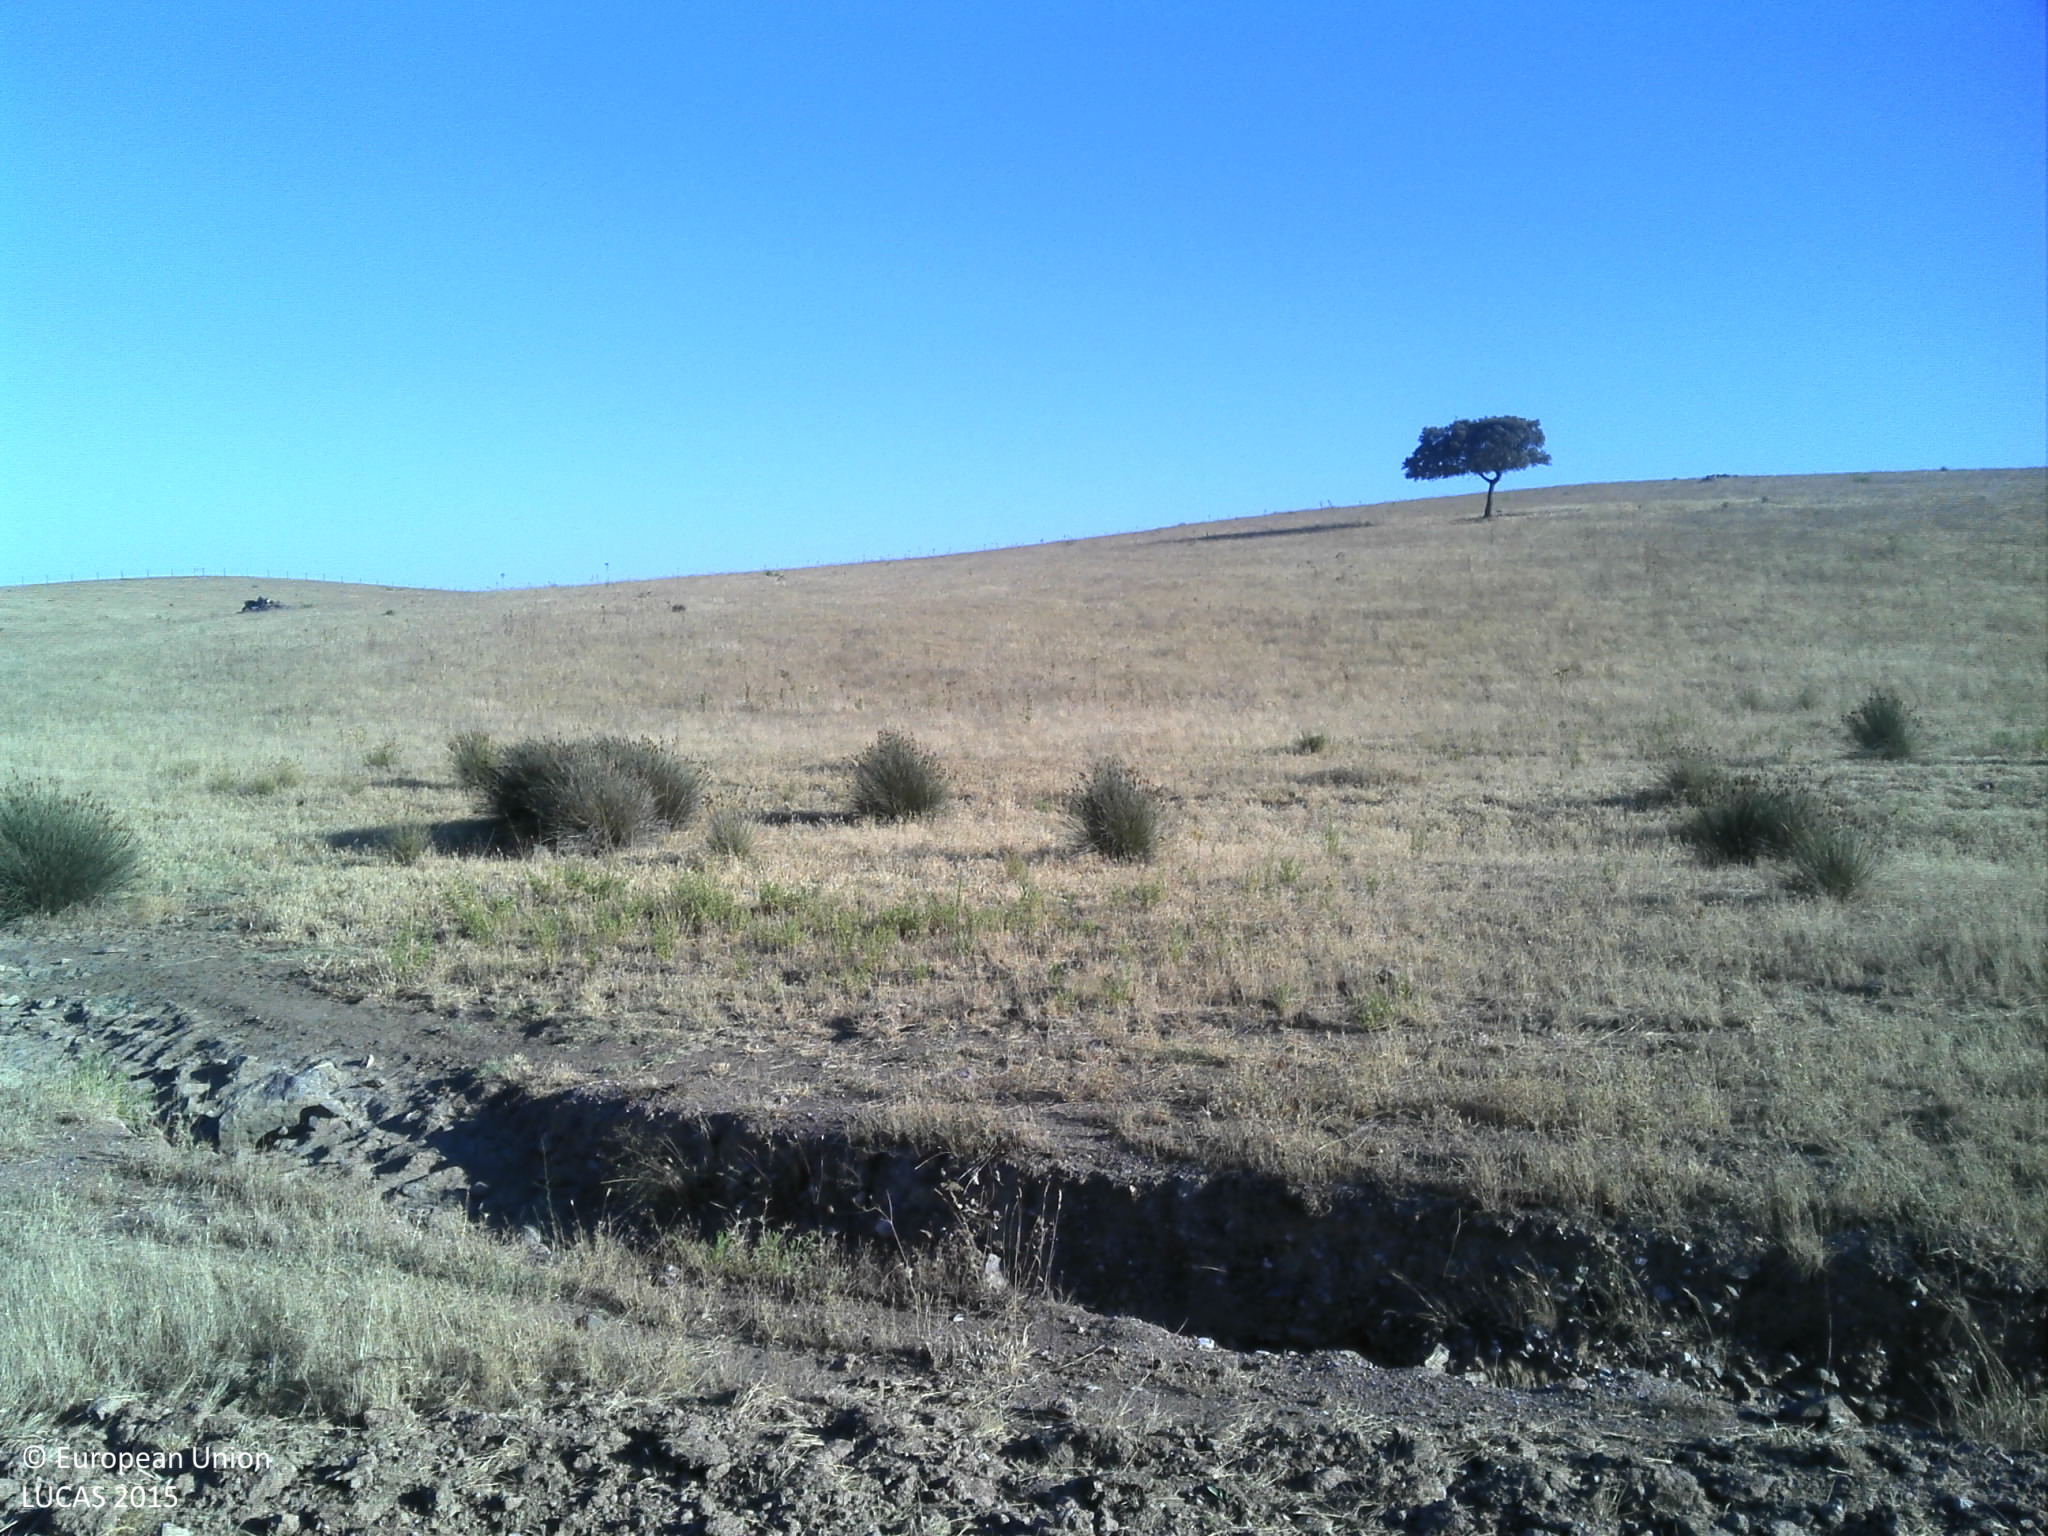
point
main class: Grassland
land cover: Grassland without tree/shrub cover
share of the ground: > 75 %
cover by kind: herbaceous plants 95 %, unconsolidated bare surface 5 %
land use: Agriculture (excluding fallow land and kitchen gardens)
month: July
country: PT
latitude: 37.8792
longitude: -8.0264
